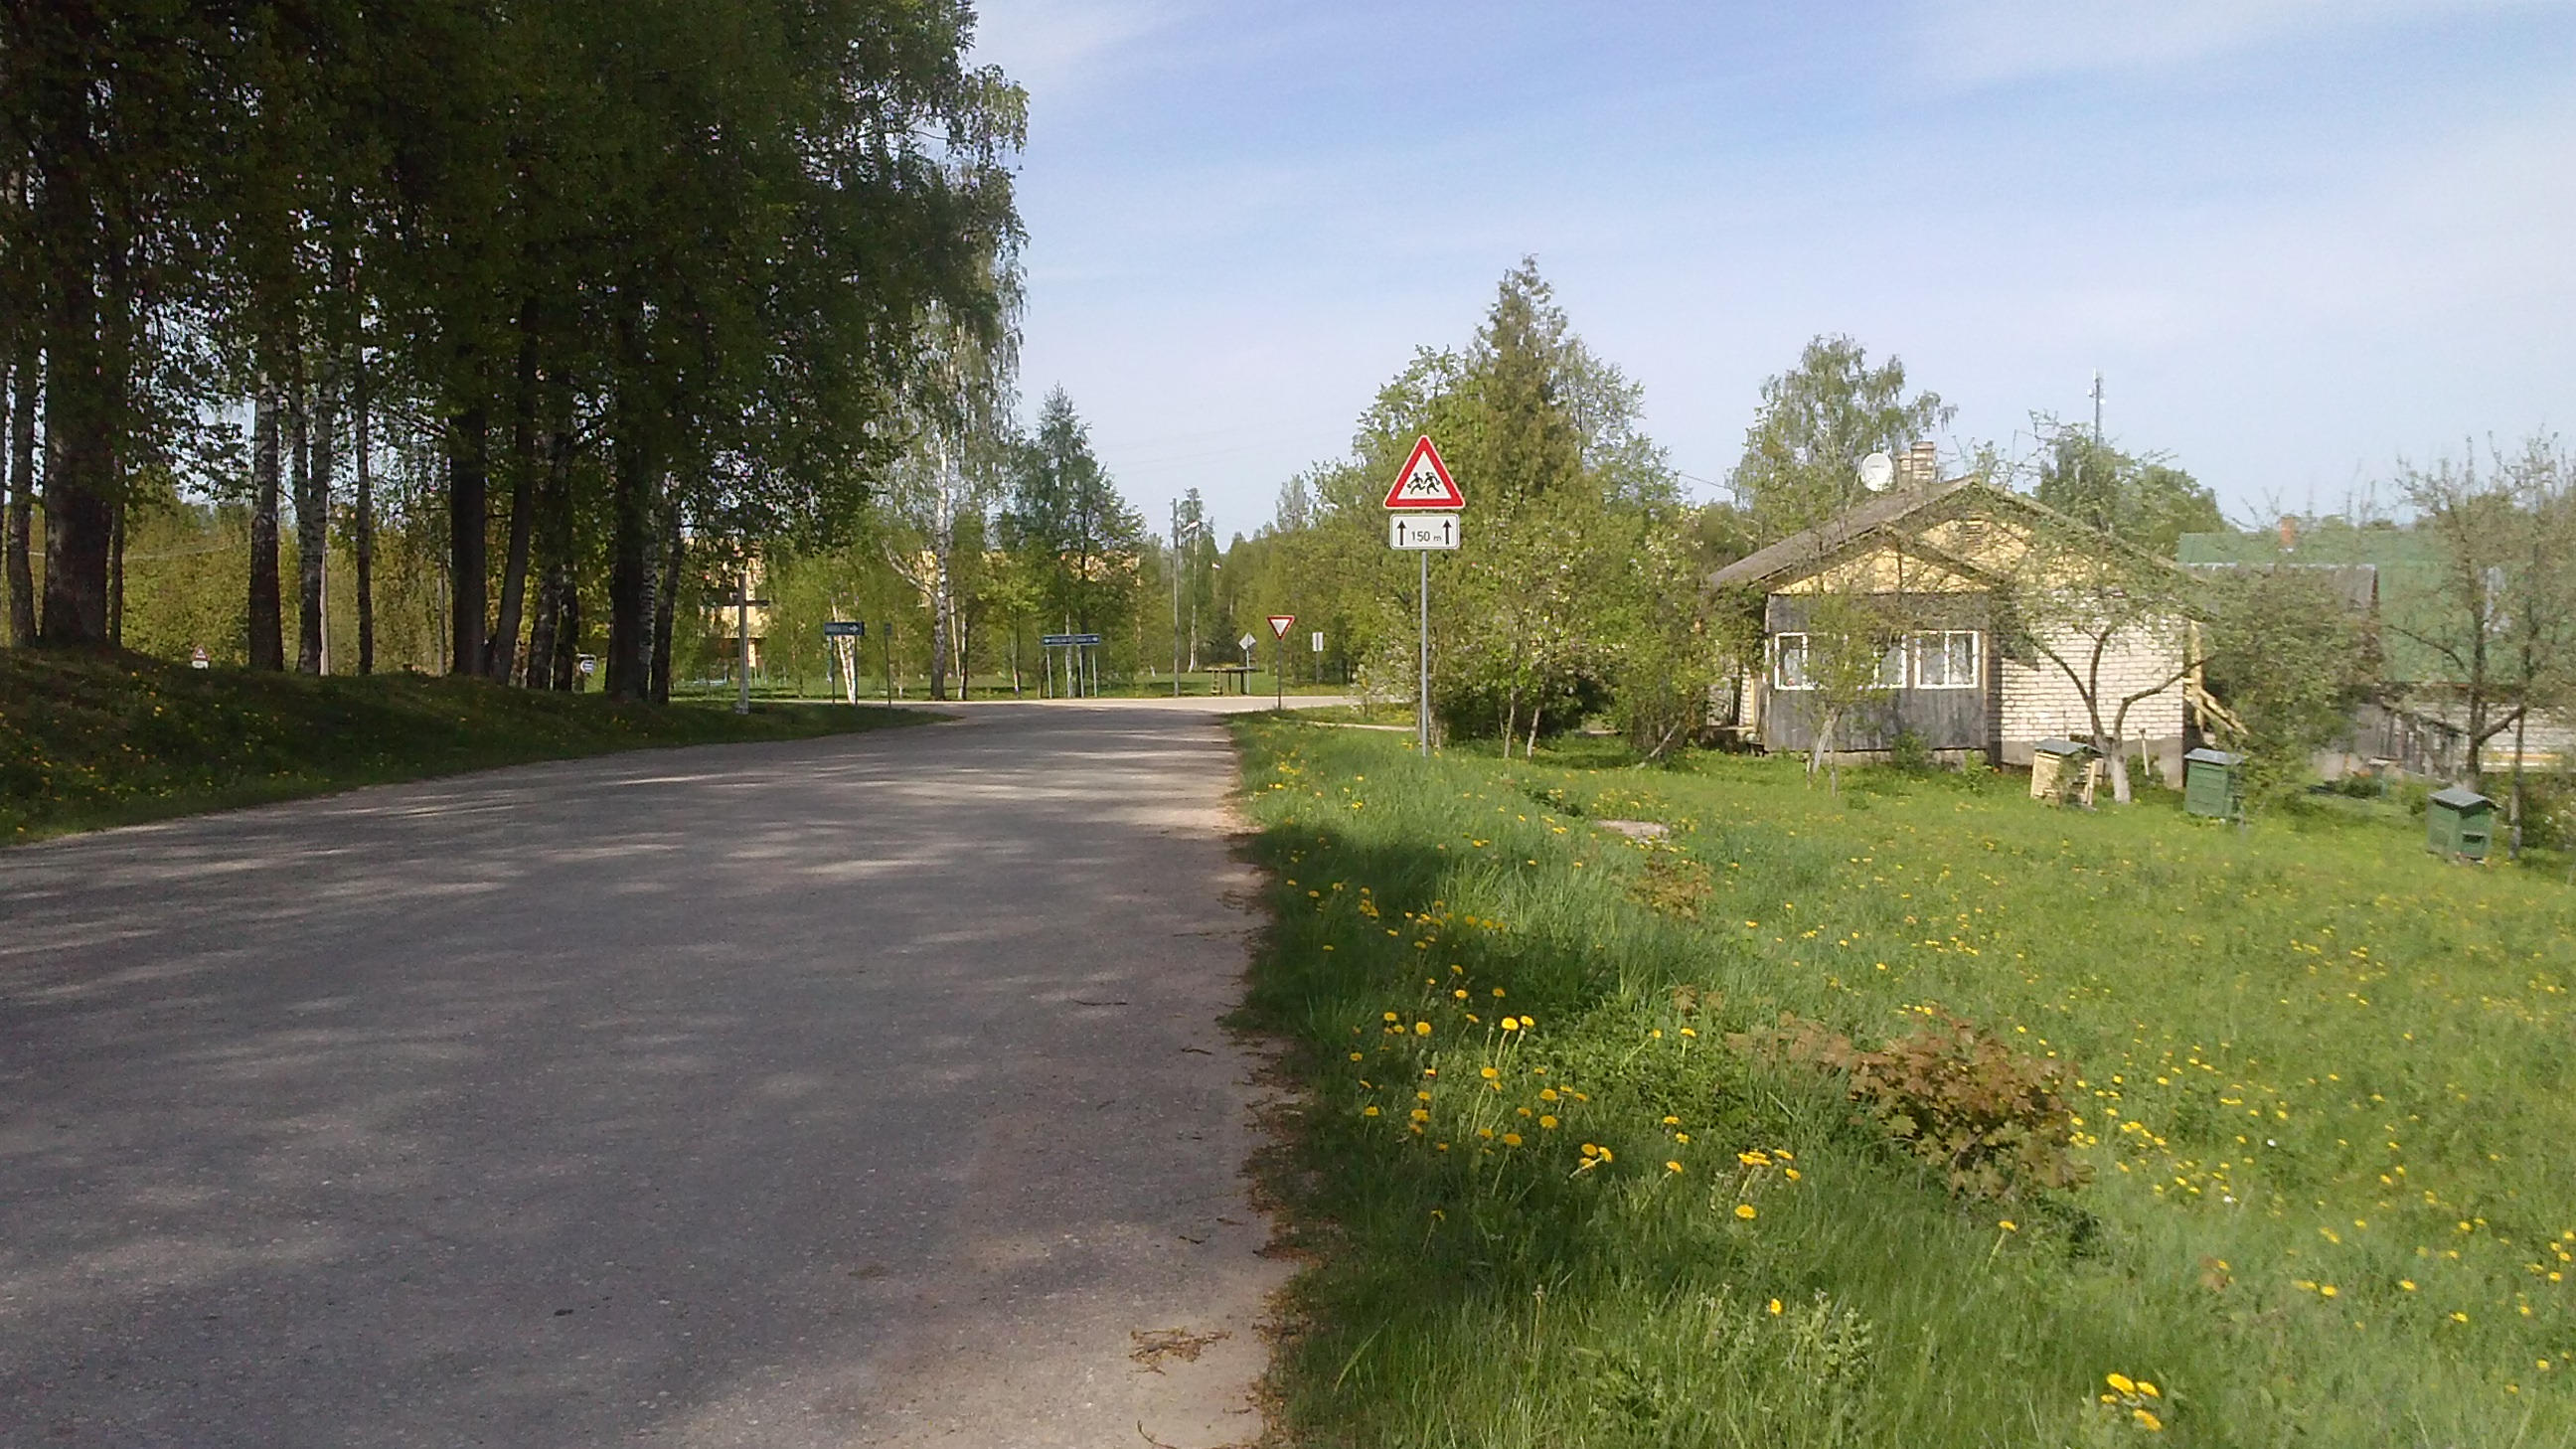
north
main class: Grassland
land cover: Grassland without tree/shrub cover
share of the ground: > 75 %
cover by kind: herbaceous plants 100 %
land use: Agriculture (excluding fallow land and kitchen gardens)
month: May
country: LV
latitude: 55.9712
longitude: 27.6020
